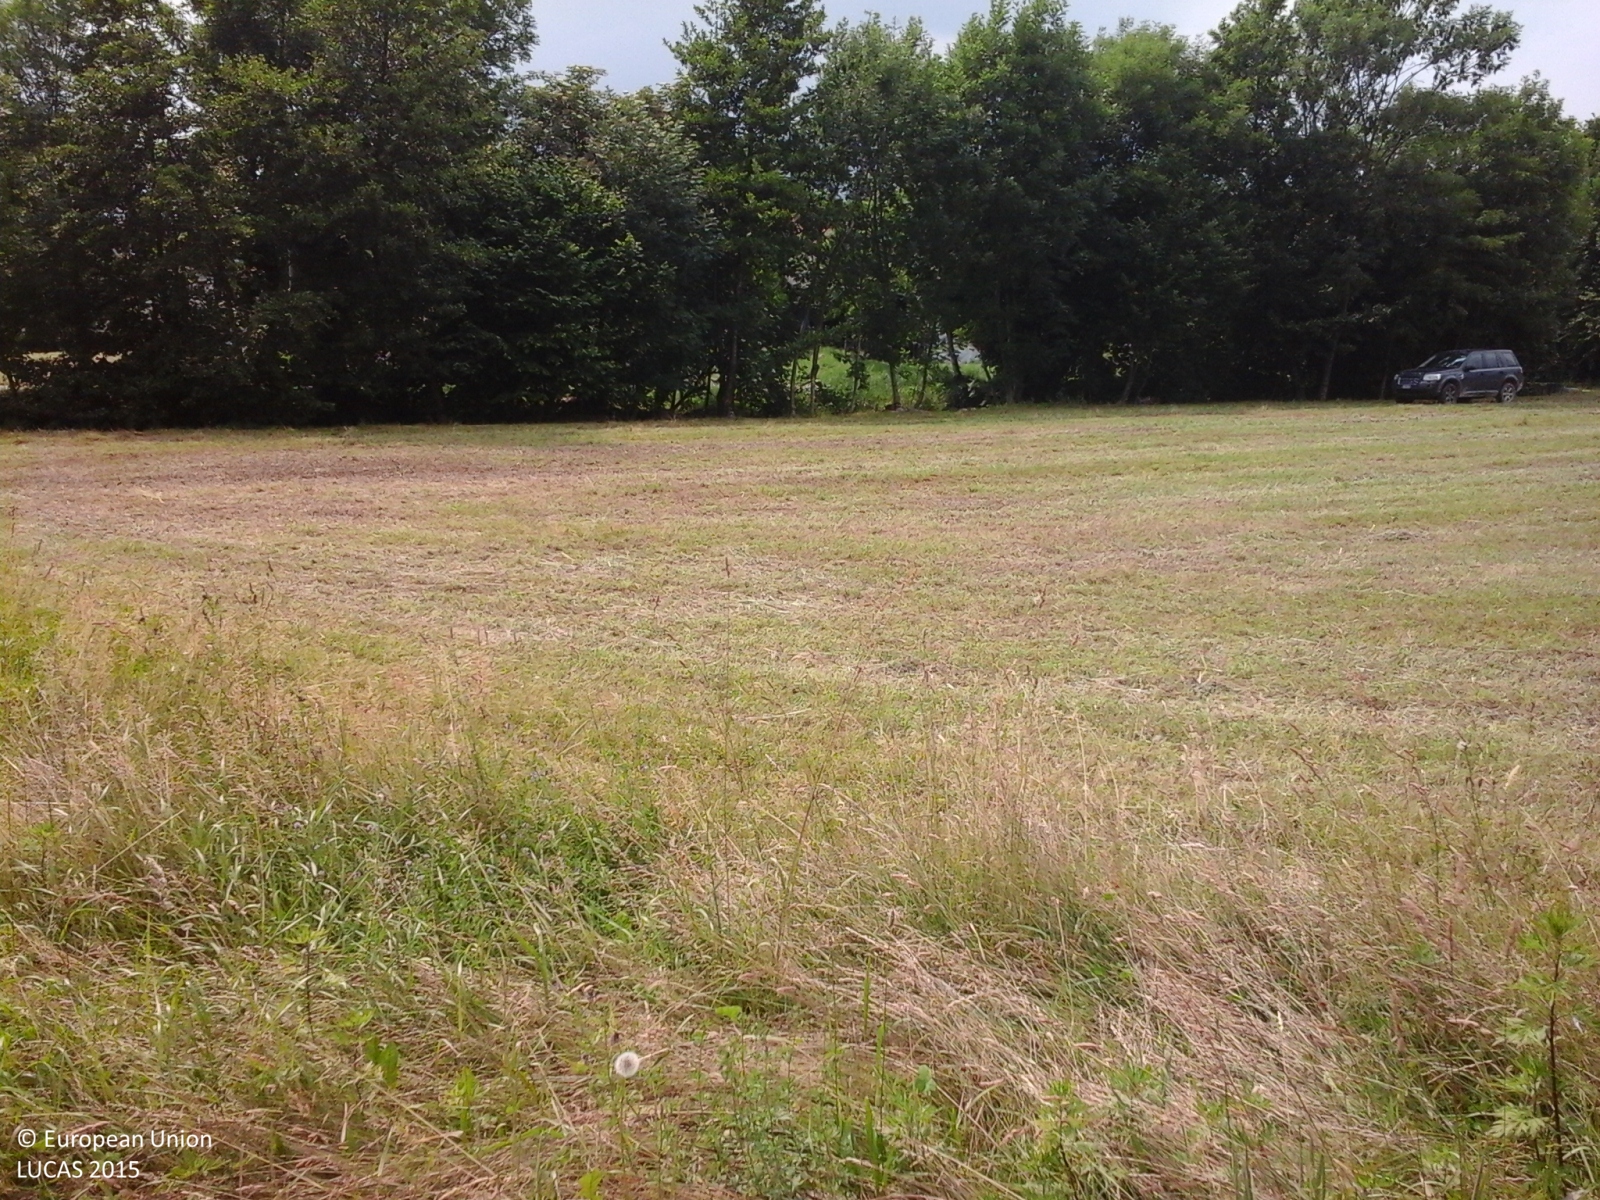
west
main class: Grassland
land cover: Grassland without tree/shrub cover
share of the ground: > 75 %
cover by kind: herbaceous plants 100 %
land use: Agriculture (excluding fallow land and kitchen gardens)
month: May
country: IT
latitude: 45.3885
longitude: 7.6664
